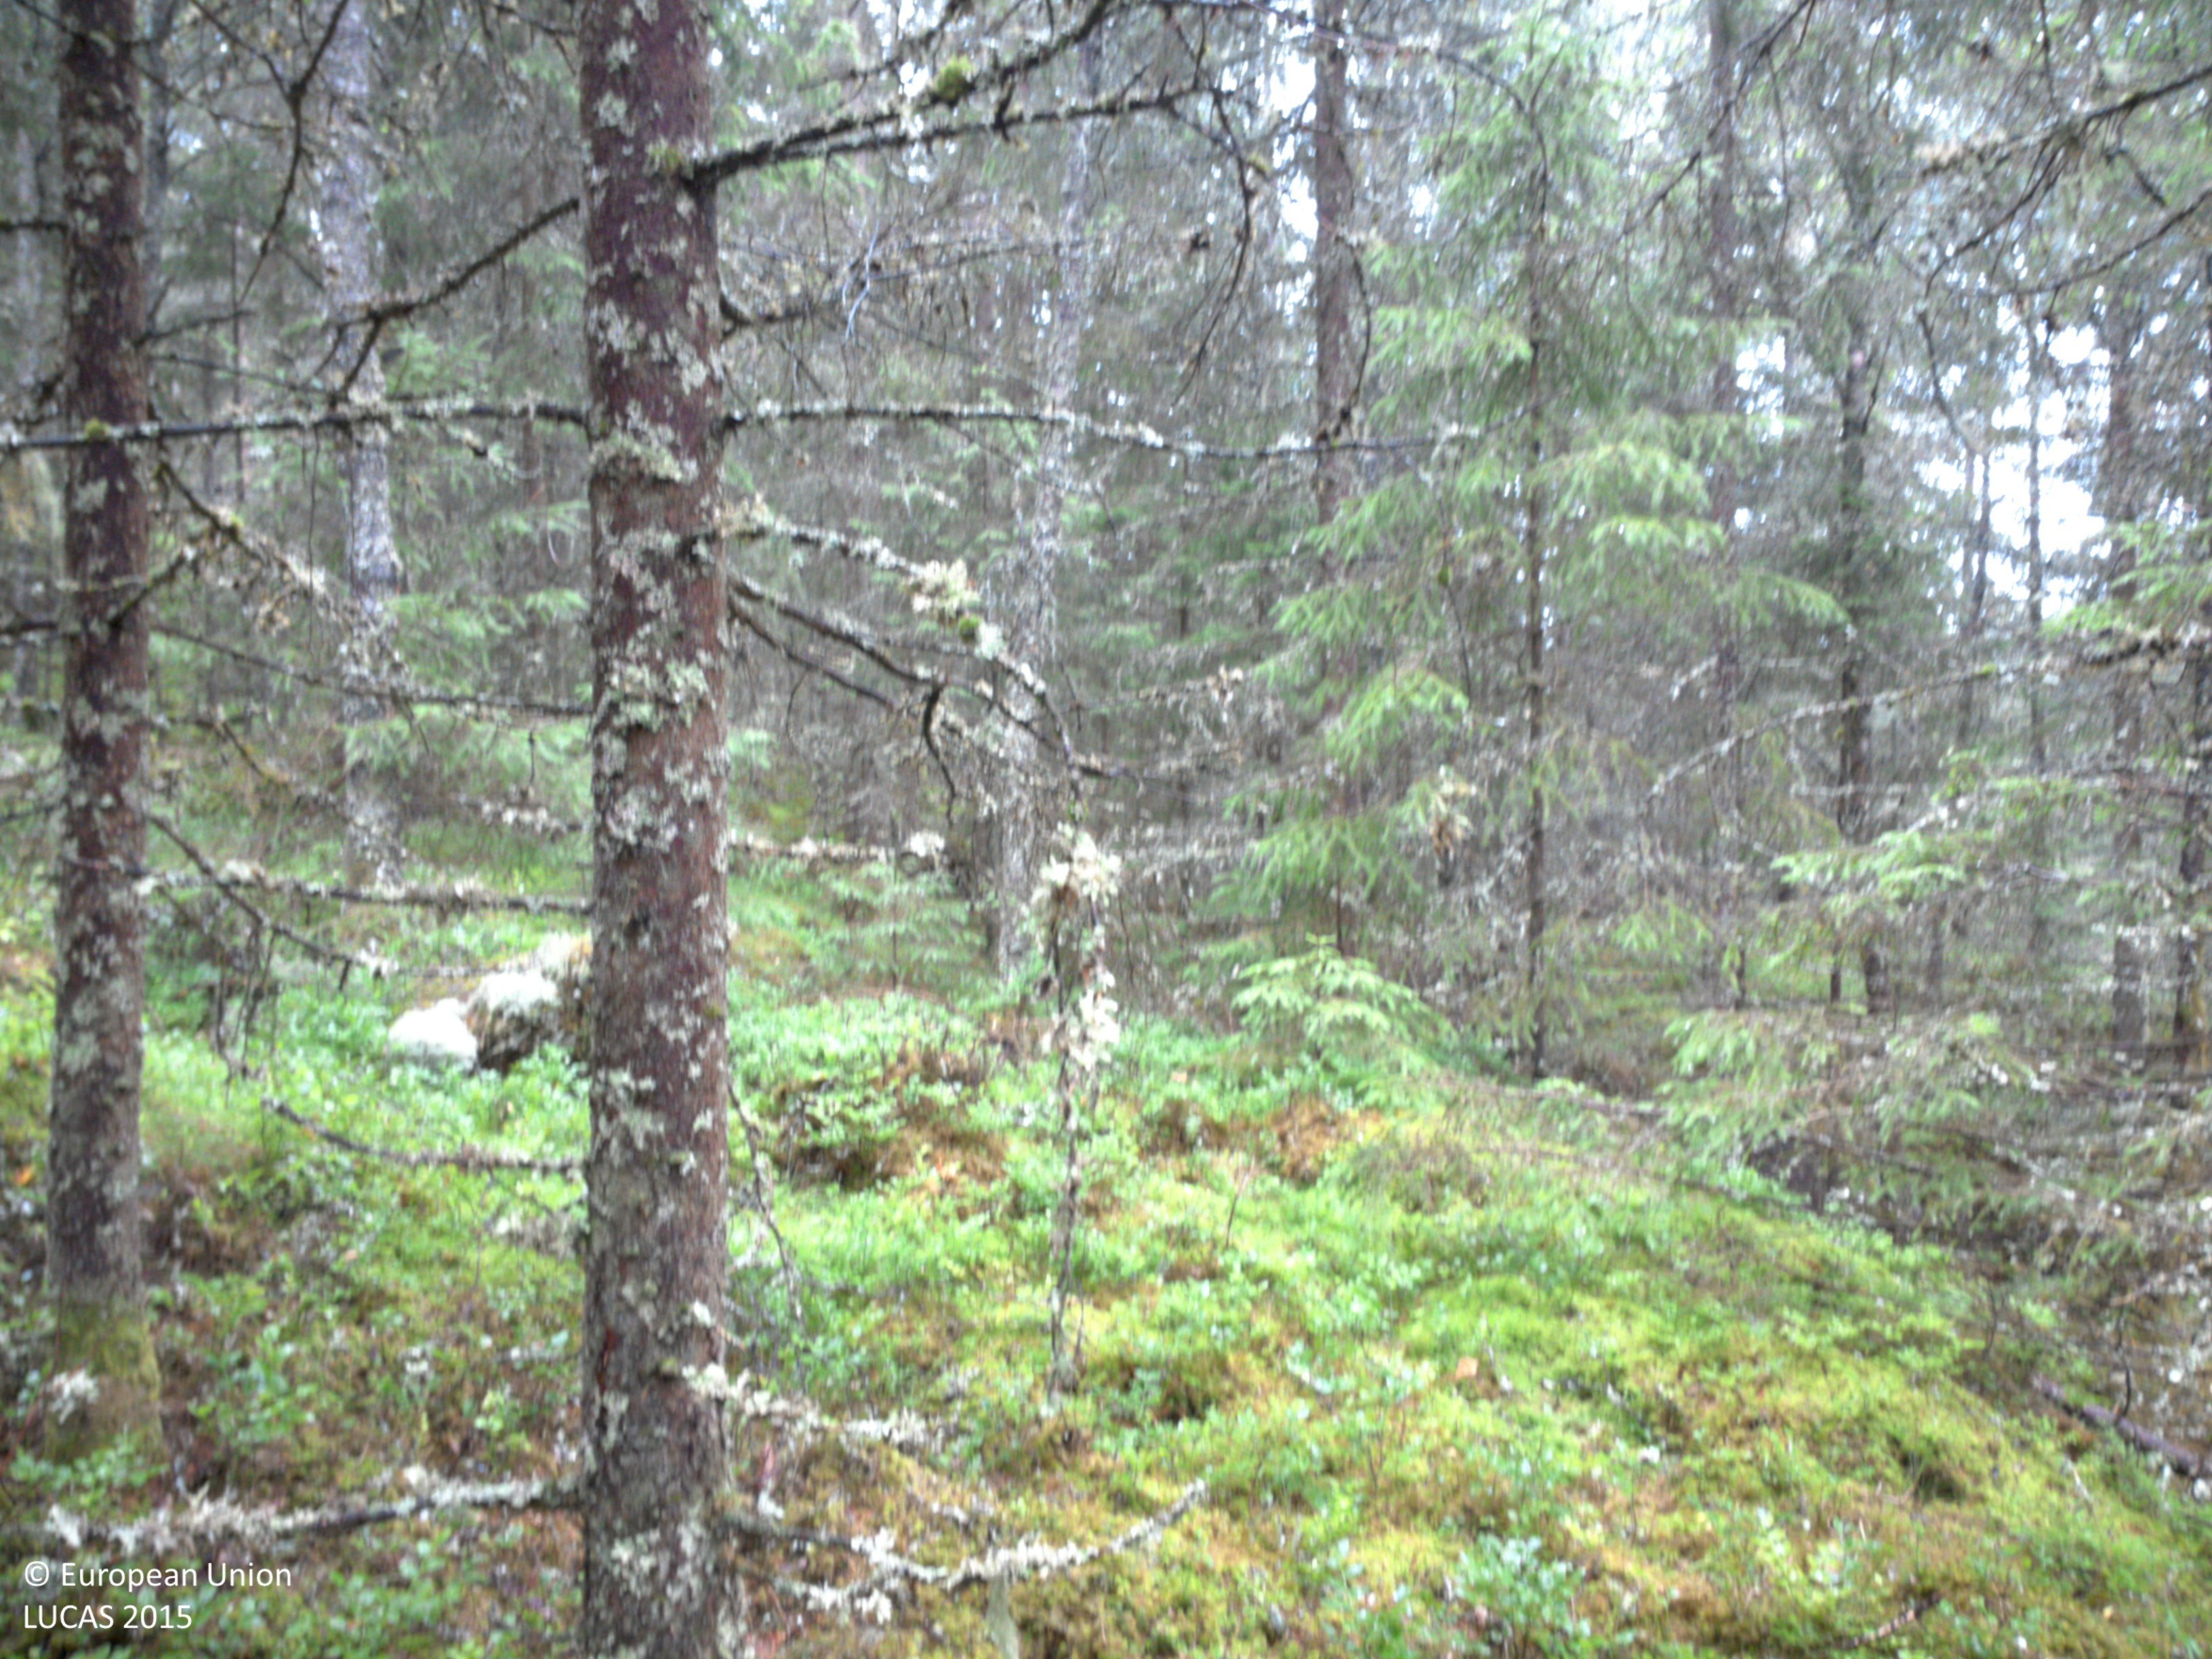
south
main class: Woodland
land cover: Spruce dominated coniferous woodland
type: boreal forest
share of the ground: 50 - 75 %
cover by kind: coniferous forest trees 70 %, lichens and mosses 20 %, shrubs 10 %
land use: Forestry
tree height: > 5 m
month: July
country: SE
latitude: 58.6957
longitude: 11.6012
